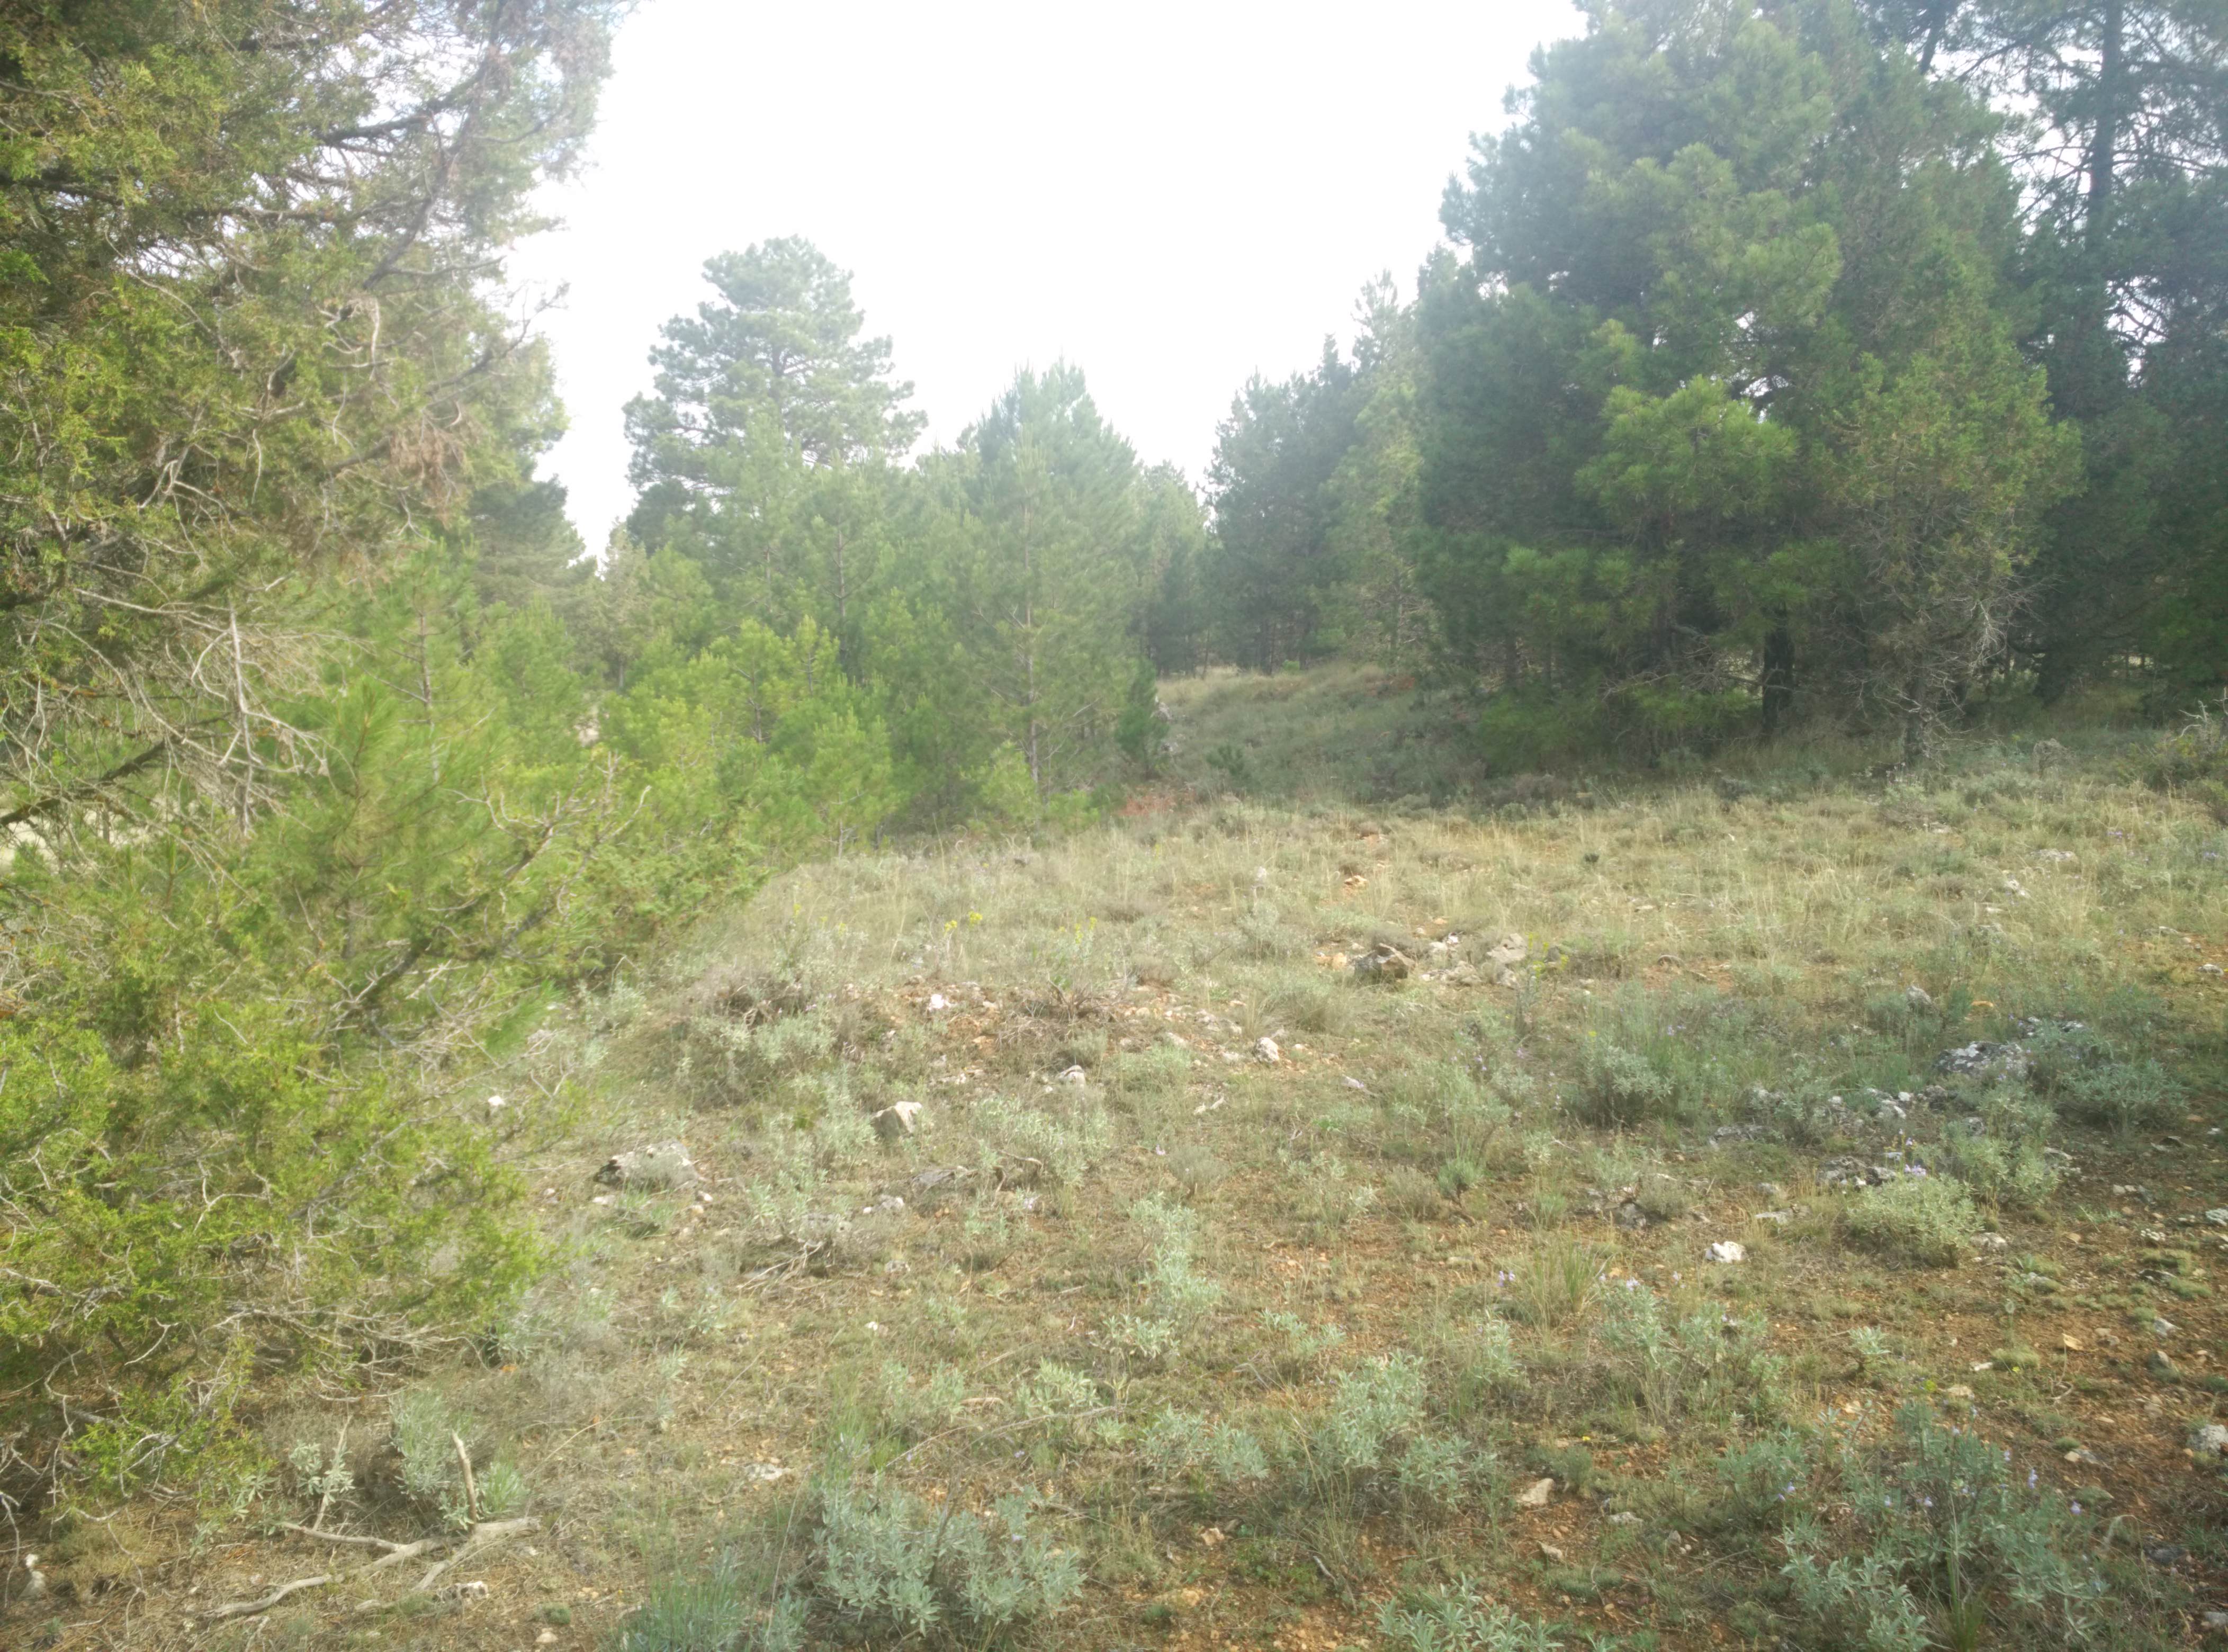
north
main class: Woodland
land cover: Pine dominated coniferous woodland
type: coniferous forest of the mediterranean region
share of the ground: 25 - 50 %
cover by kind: unconsolidated bare surface 40 %, coniferous forest trees 35 %, shrubs 20 %, herbaceous plants 5 %
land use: Semi-natural and natural areas not in use
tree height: > 5 m
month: June
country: ES
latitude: 40.7343
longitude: -1.9933
